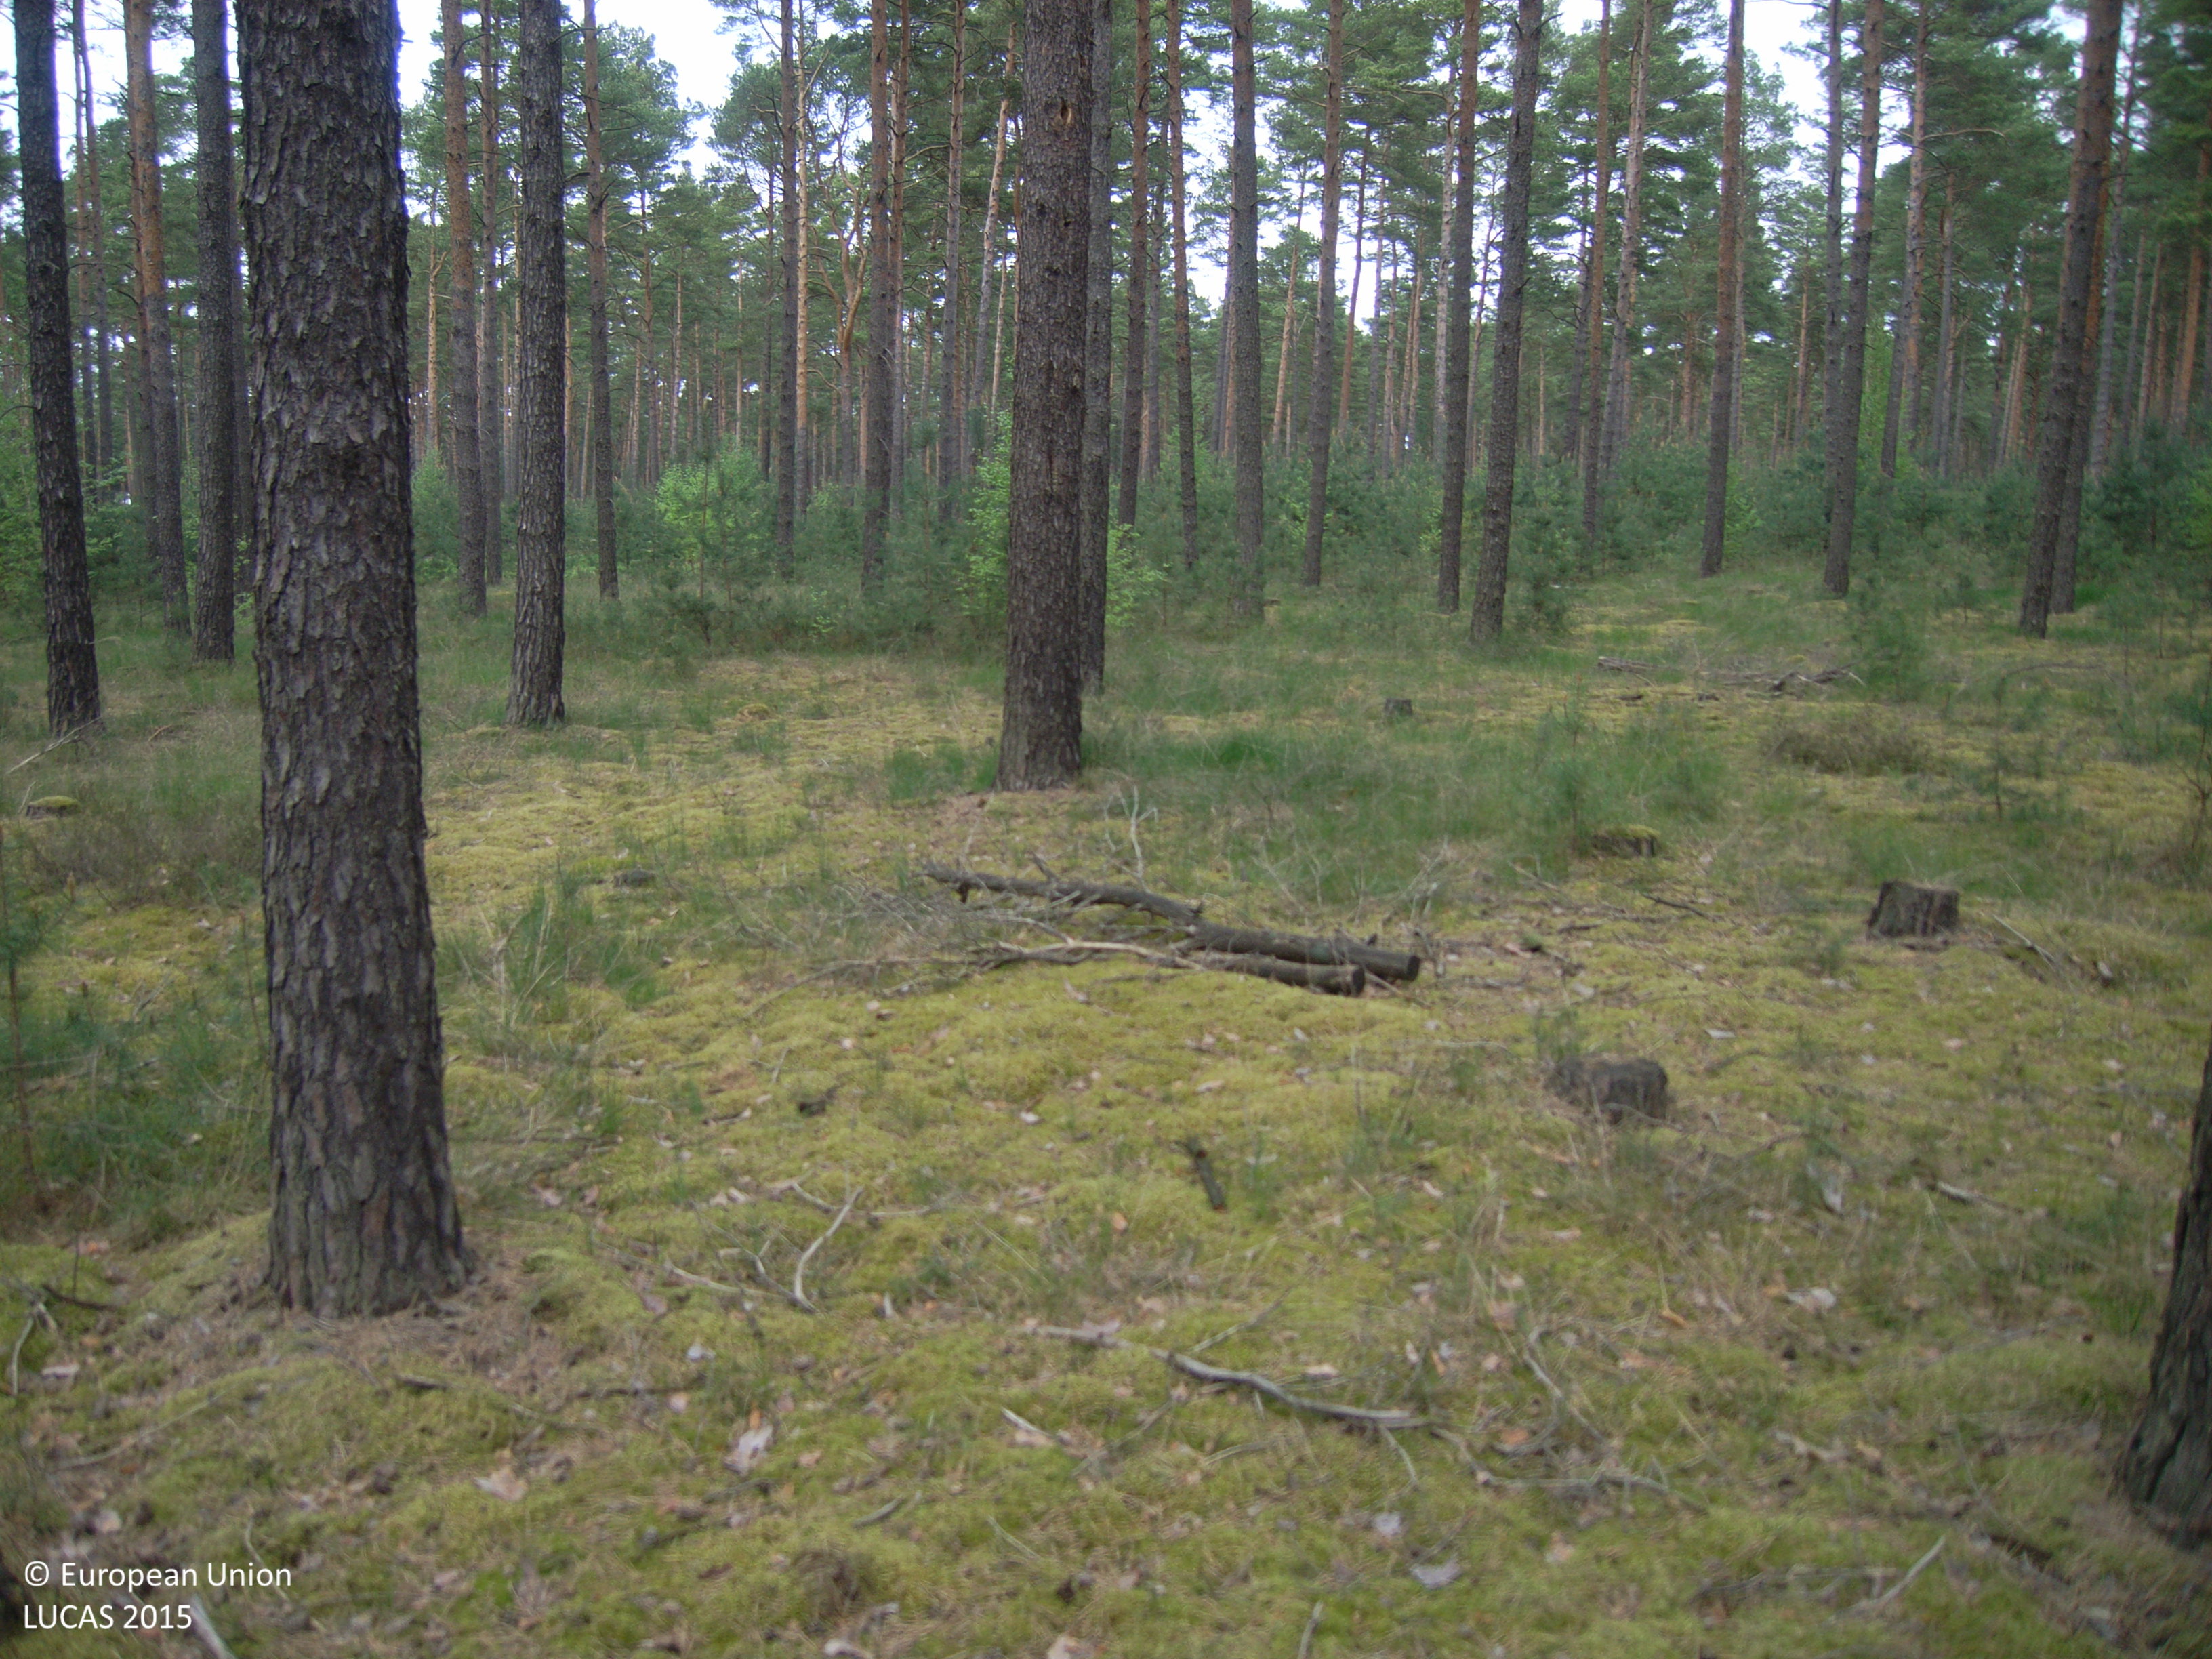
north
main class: Woodland
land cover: Pine dominated coniferous woodland
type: hemiboreal forest and nemoral coniferous forest and mixed broadleaved-coniferous forest
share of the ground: > 75 %
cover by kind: coniferous forest trees 100 %
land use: Forestry
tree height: > 5 m
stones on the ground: < 10 %
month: May
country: DE
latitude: 52.0898
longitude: 13.5762
